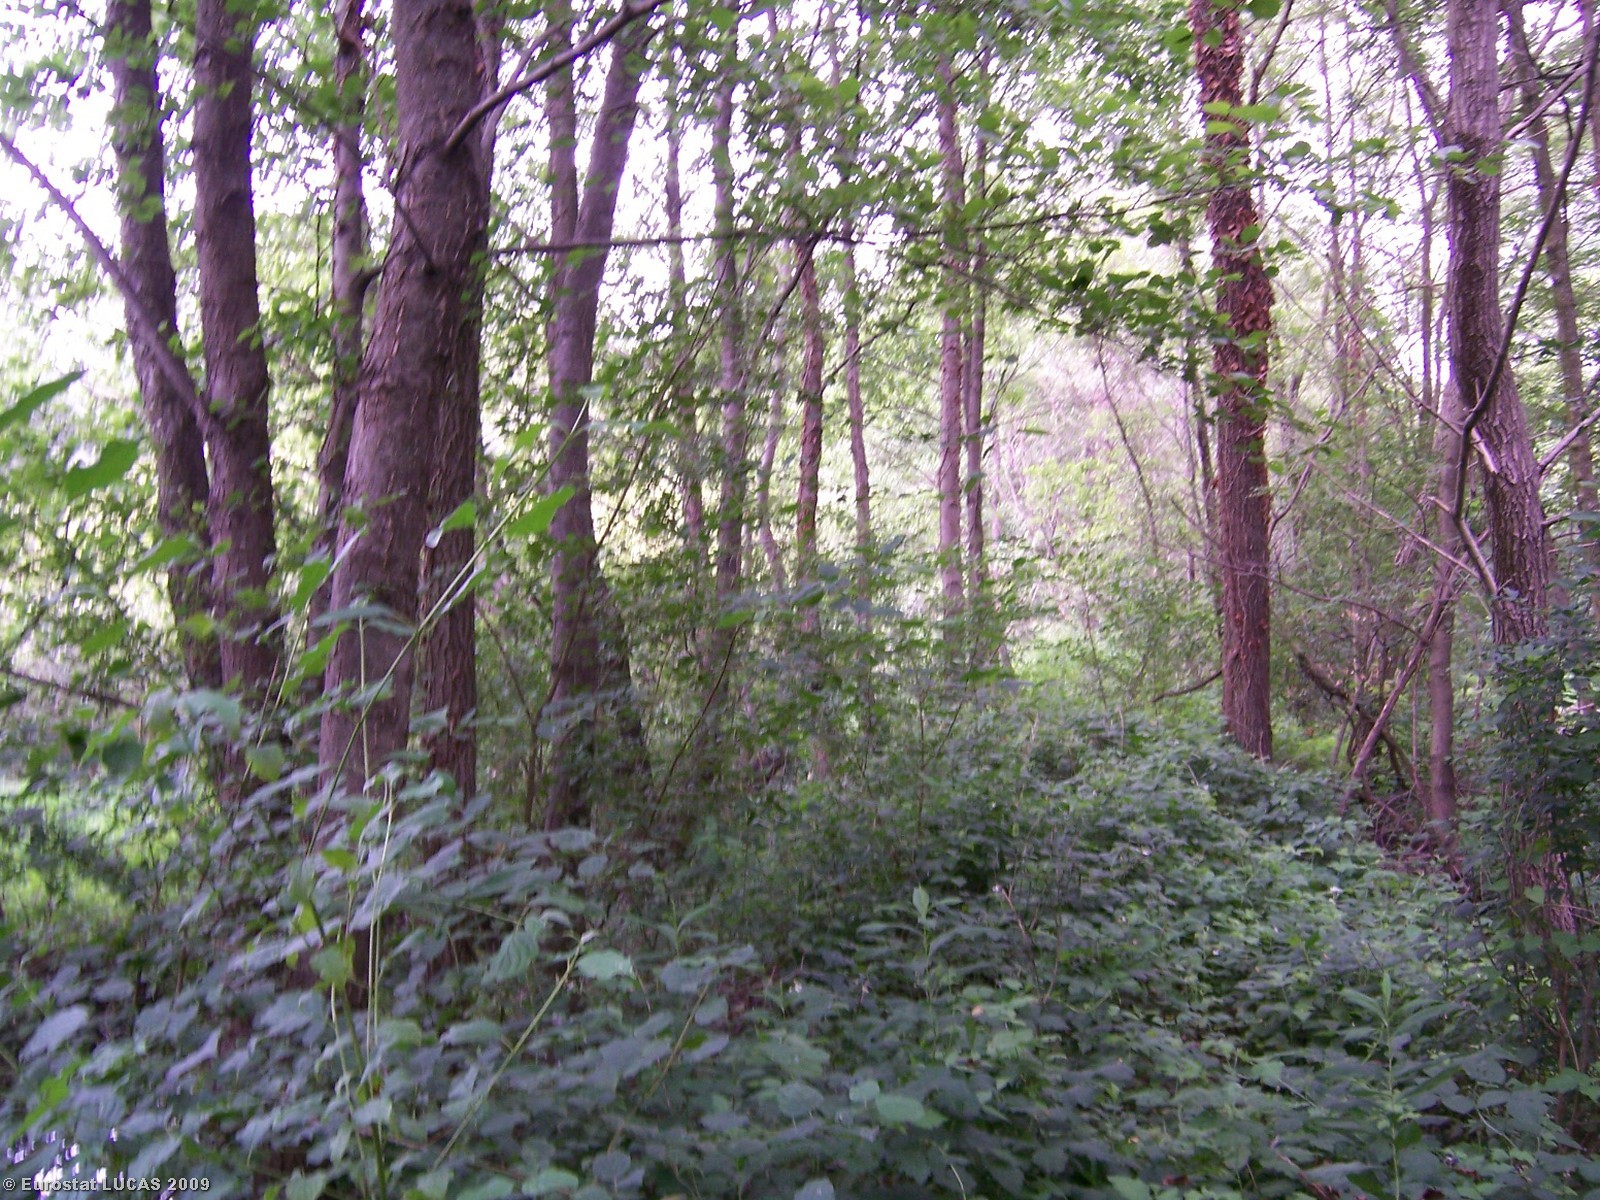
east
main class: Woodland
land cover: Broadleaved woodland
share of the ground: > 75 %
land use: Nature reserves
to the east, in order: Broadleaved woodland; Grassland without tree/shrub cover; Tracks
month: July
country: IT
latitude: 45.0751
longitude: 7.3751
